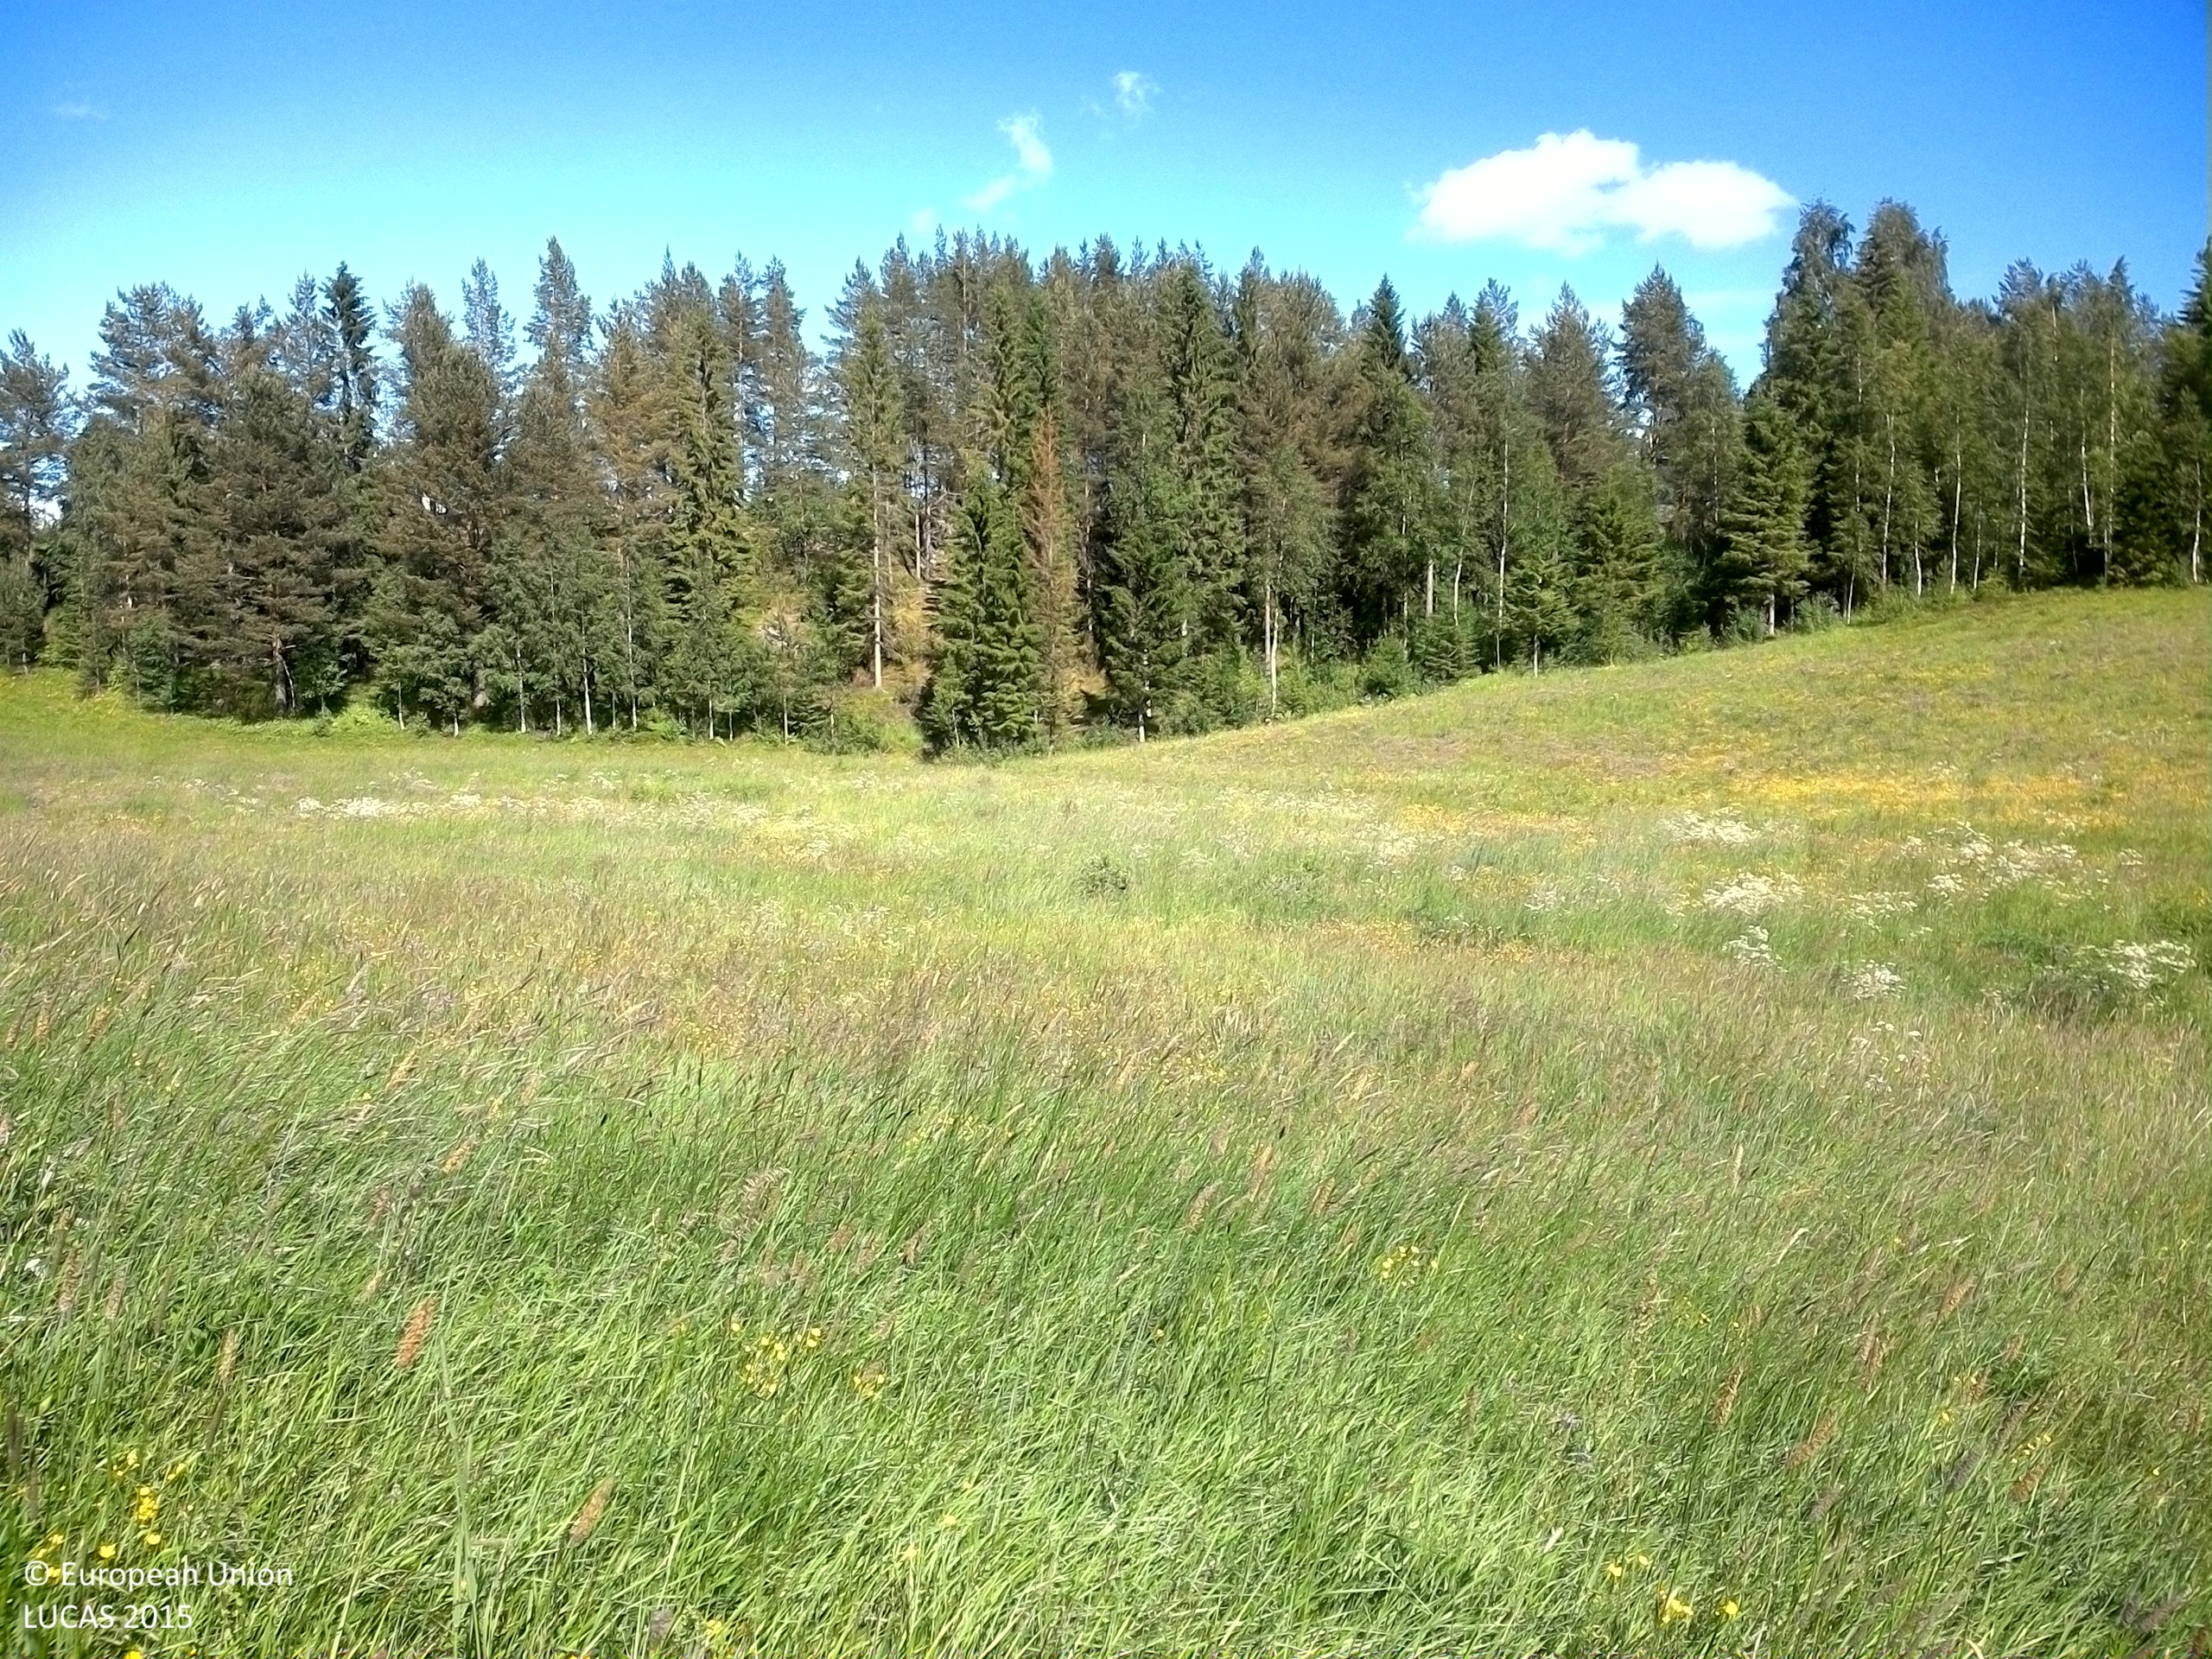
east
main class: Grassland
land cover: Grassland without tree/shrub cover
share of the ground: > 75 %
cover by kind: herbaceous plants 95 %, lichens and mosses 5 %
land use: Agriculture (excluding fallow land and kitchen gardens)
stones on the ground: < 10 %
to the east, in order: Grassland without tree/shrub cover; Spruce dominated mixed woodland; Artificial constructions in urban areas; Broadleaved woodland; Electric lines; Ditches and canals; Paved roads, cycling and walking lanes; Grass margins; Broadleaved woodland; Grassland without tree/shrub cover
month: June
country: SE
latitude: 62.8286
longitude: 17.7713
